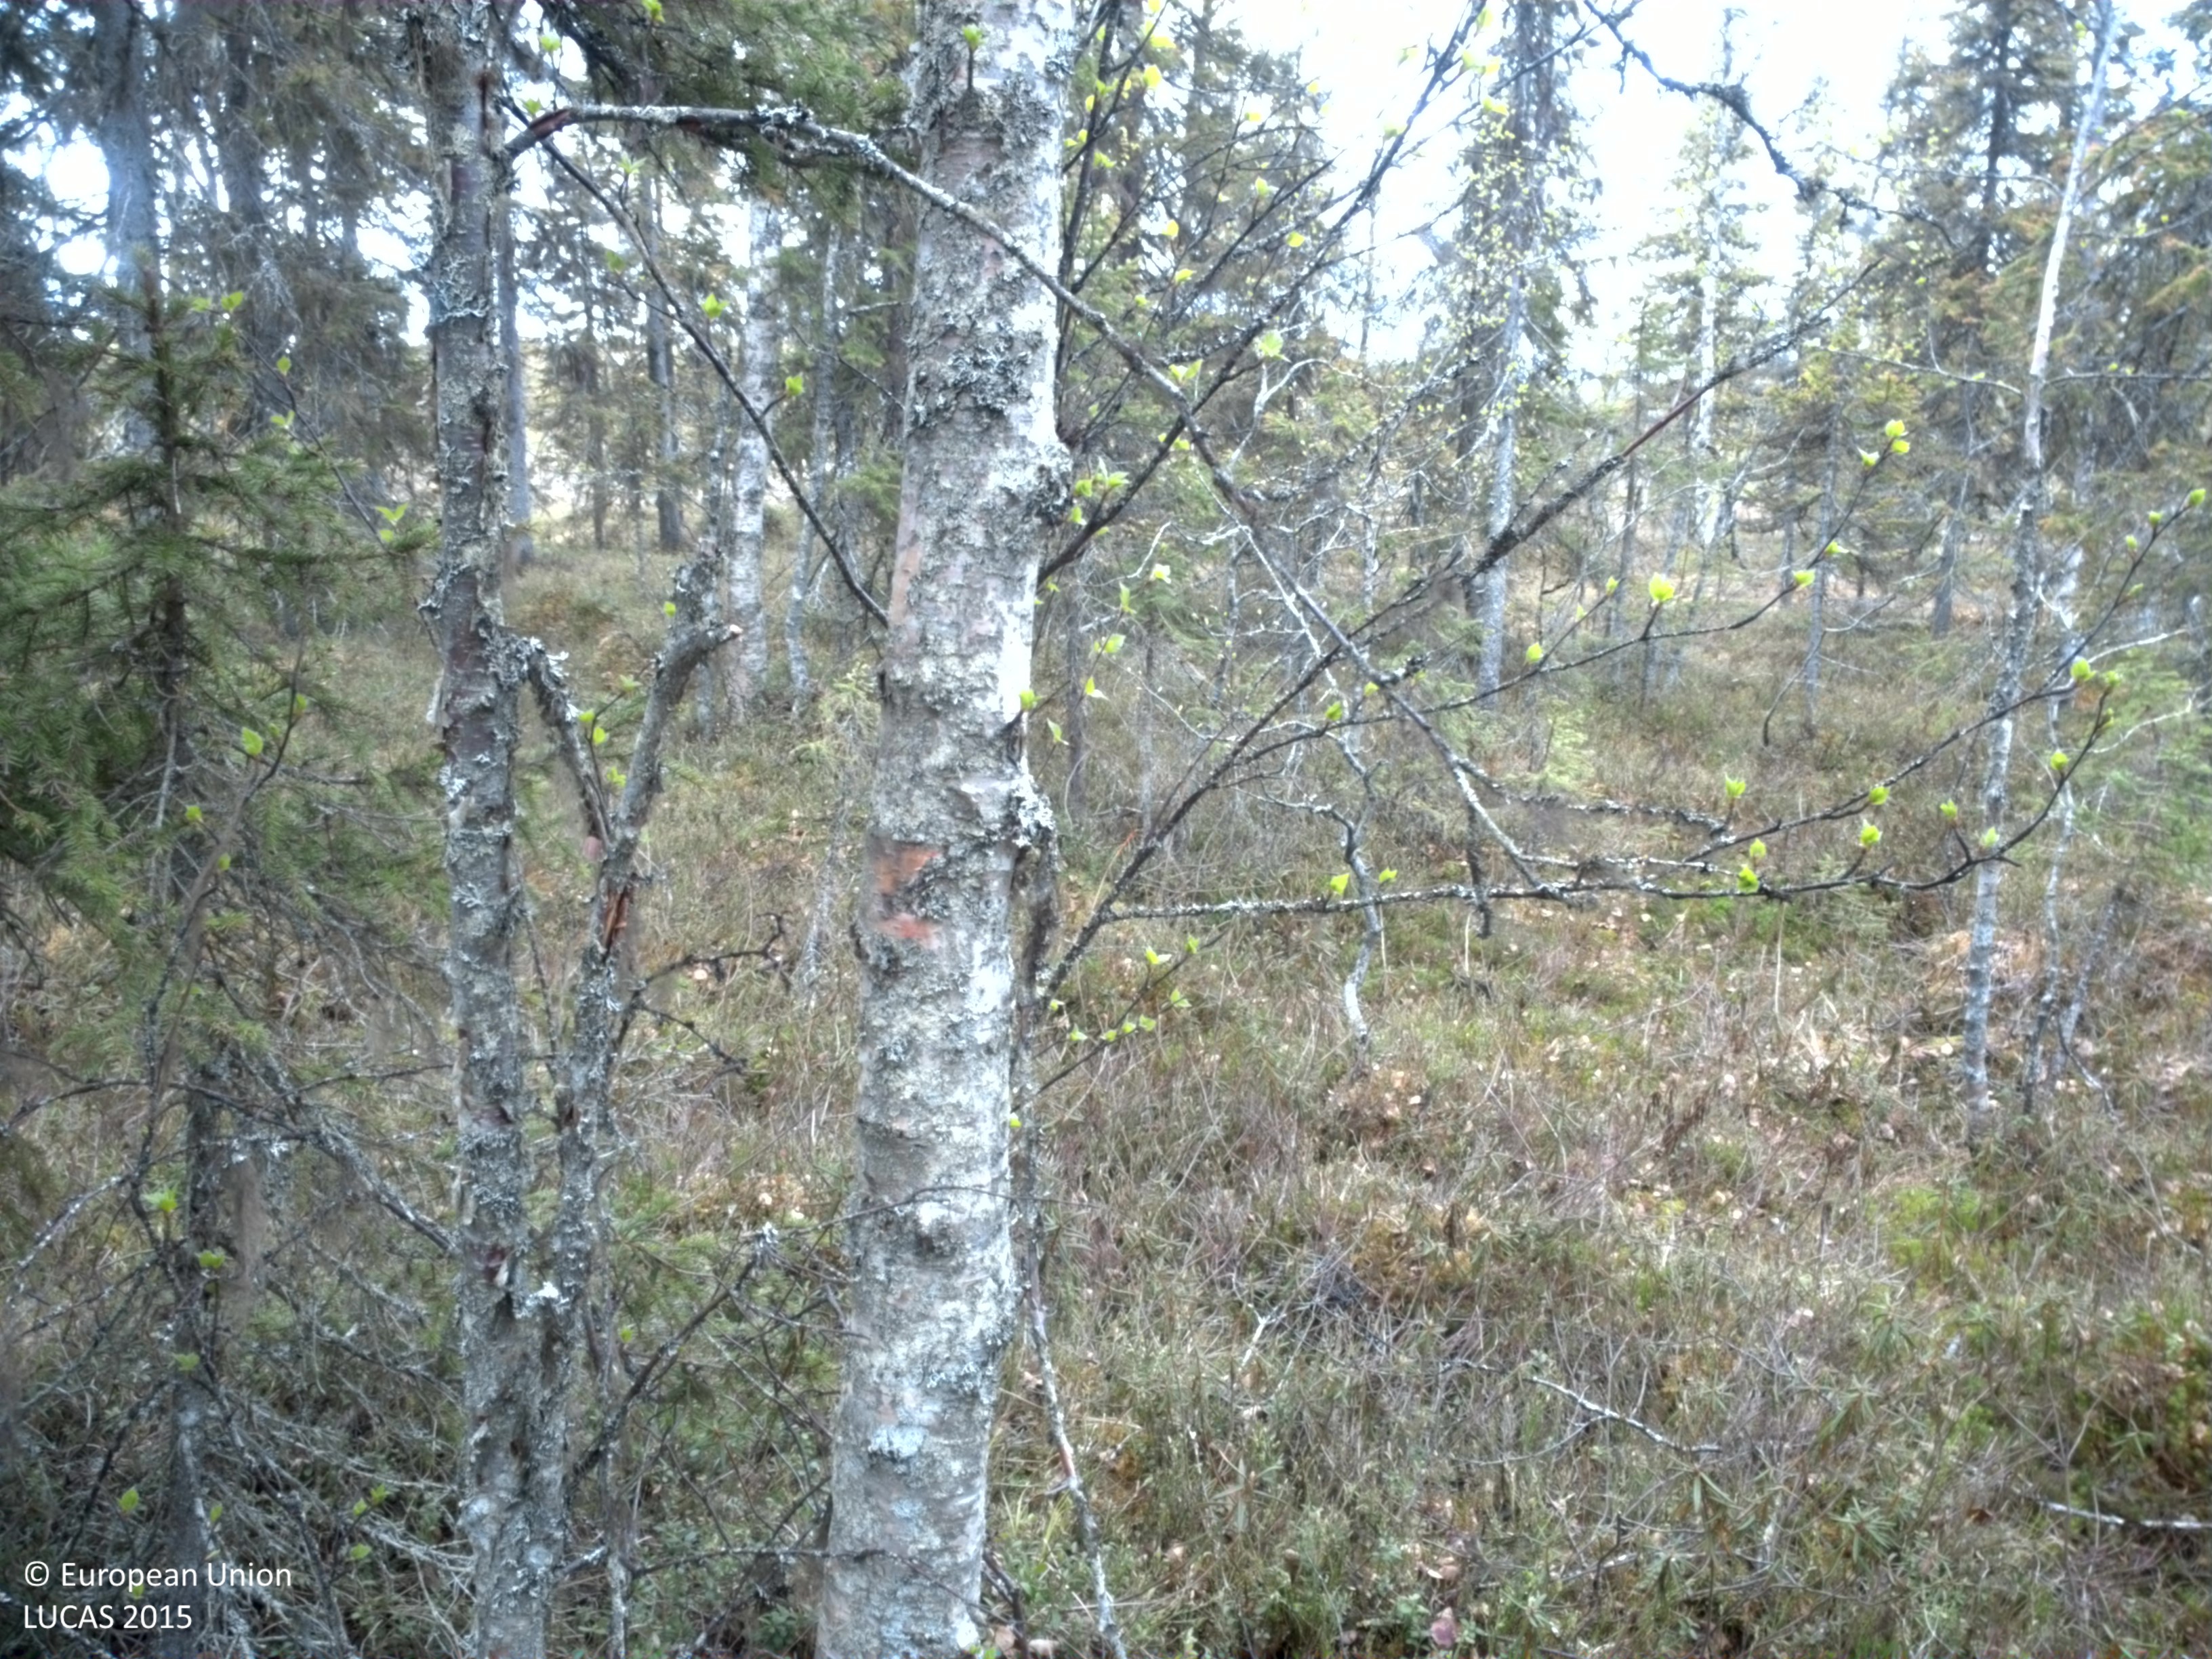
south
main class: Woodland
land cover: Spruce dominated mixed woodland
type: boreal forest
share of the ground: 50 - 75 %
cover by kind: coniferous forest trees 50 %, broadleaved forest trees 25 %, shrubs 25 %
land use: Forestry
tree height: > 5 m
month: June
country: SE
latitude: 66.4735
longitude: 23.4311
